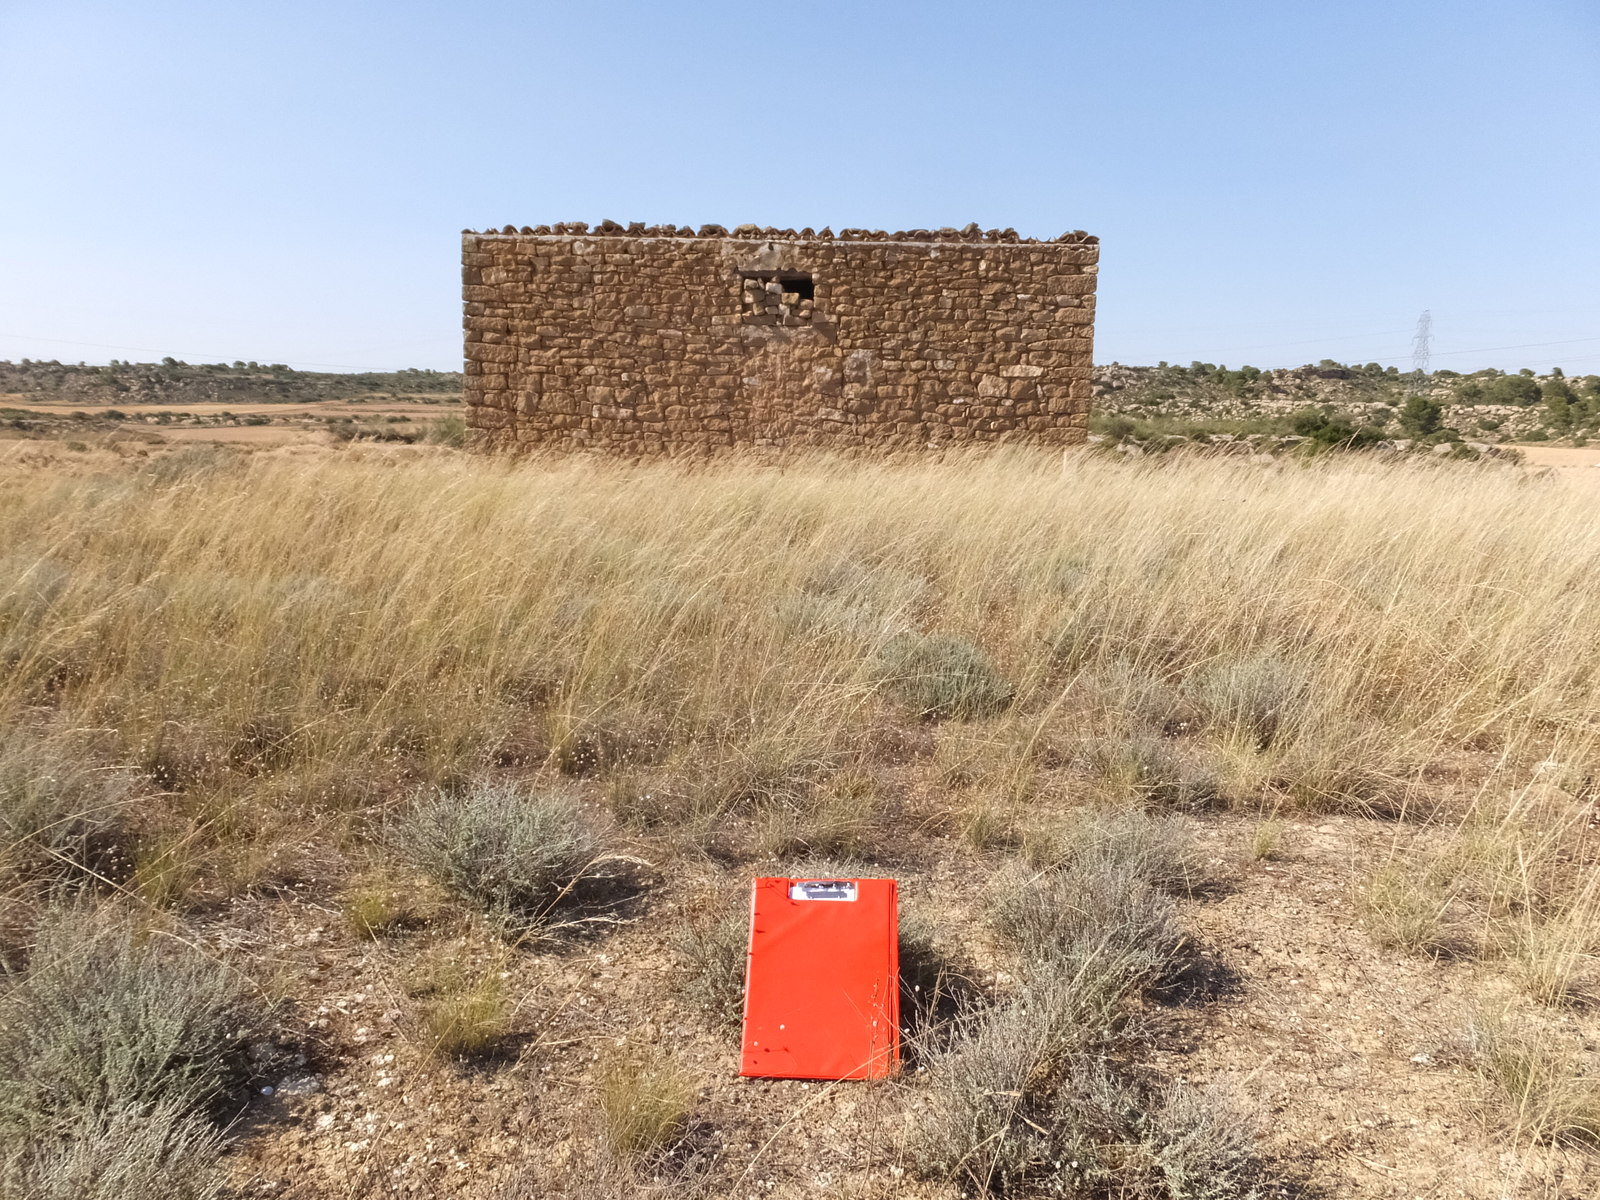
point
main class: Grassland
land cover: Grassland without tree/shrub cover
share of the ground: > 75 %
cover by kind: herbaceous plants 50 %, consolidated bare surface 50 %
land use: Semi-natural and natural areas not in use
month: June
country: ES
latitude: 41.2445
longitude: -0.2161
